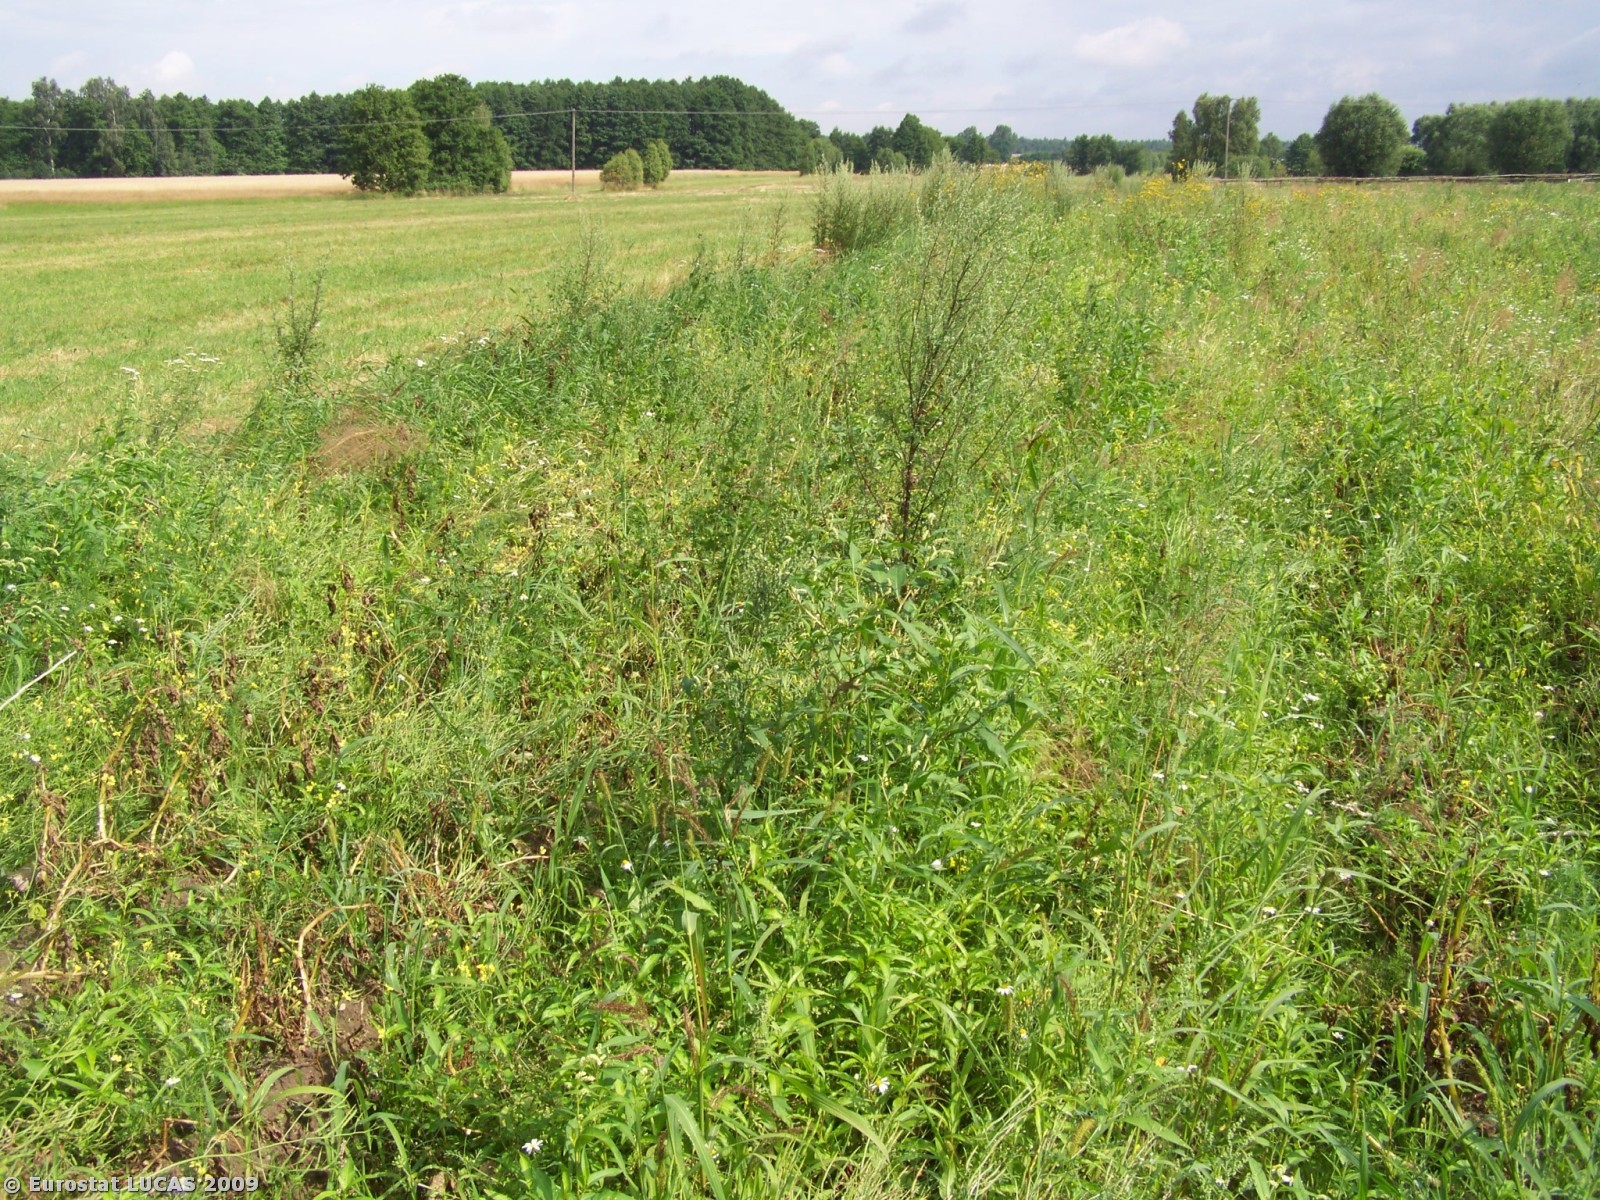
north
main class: Cropland
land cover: Potatoes
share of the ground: > 75 %
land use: Agriculture (excluding fallow land and kitchen gardens)
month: July
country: PL
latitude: 52.2631
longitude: 21.9403
